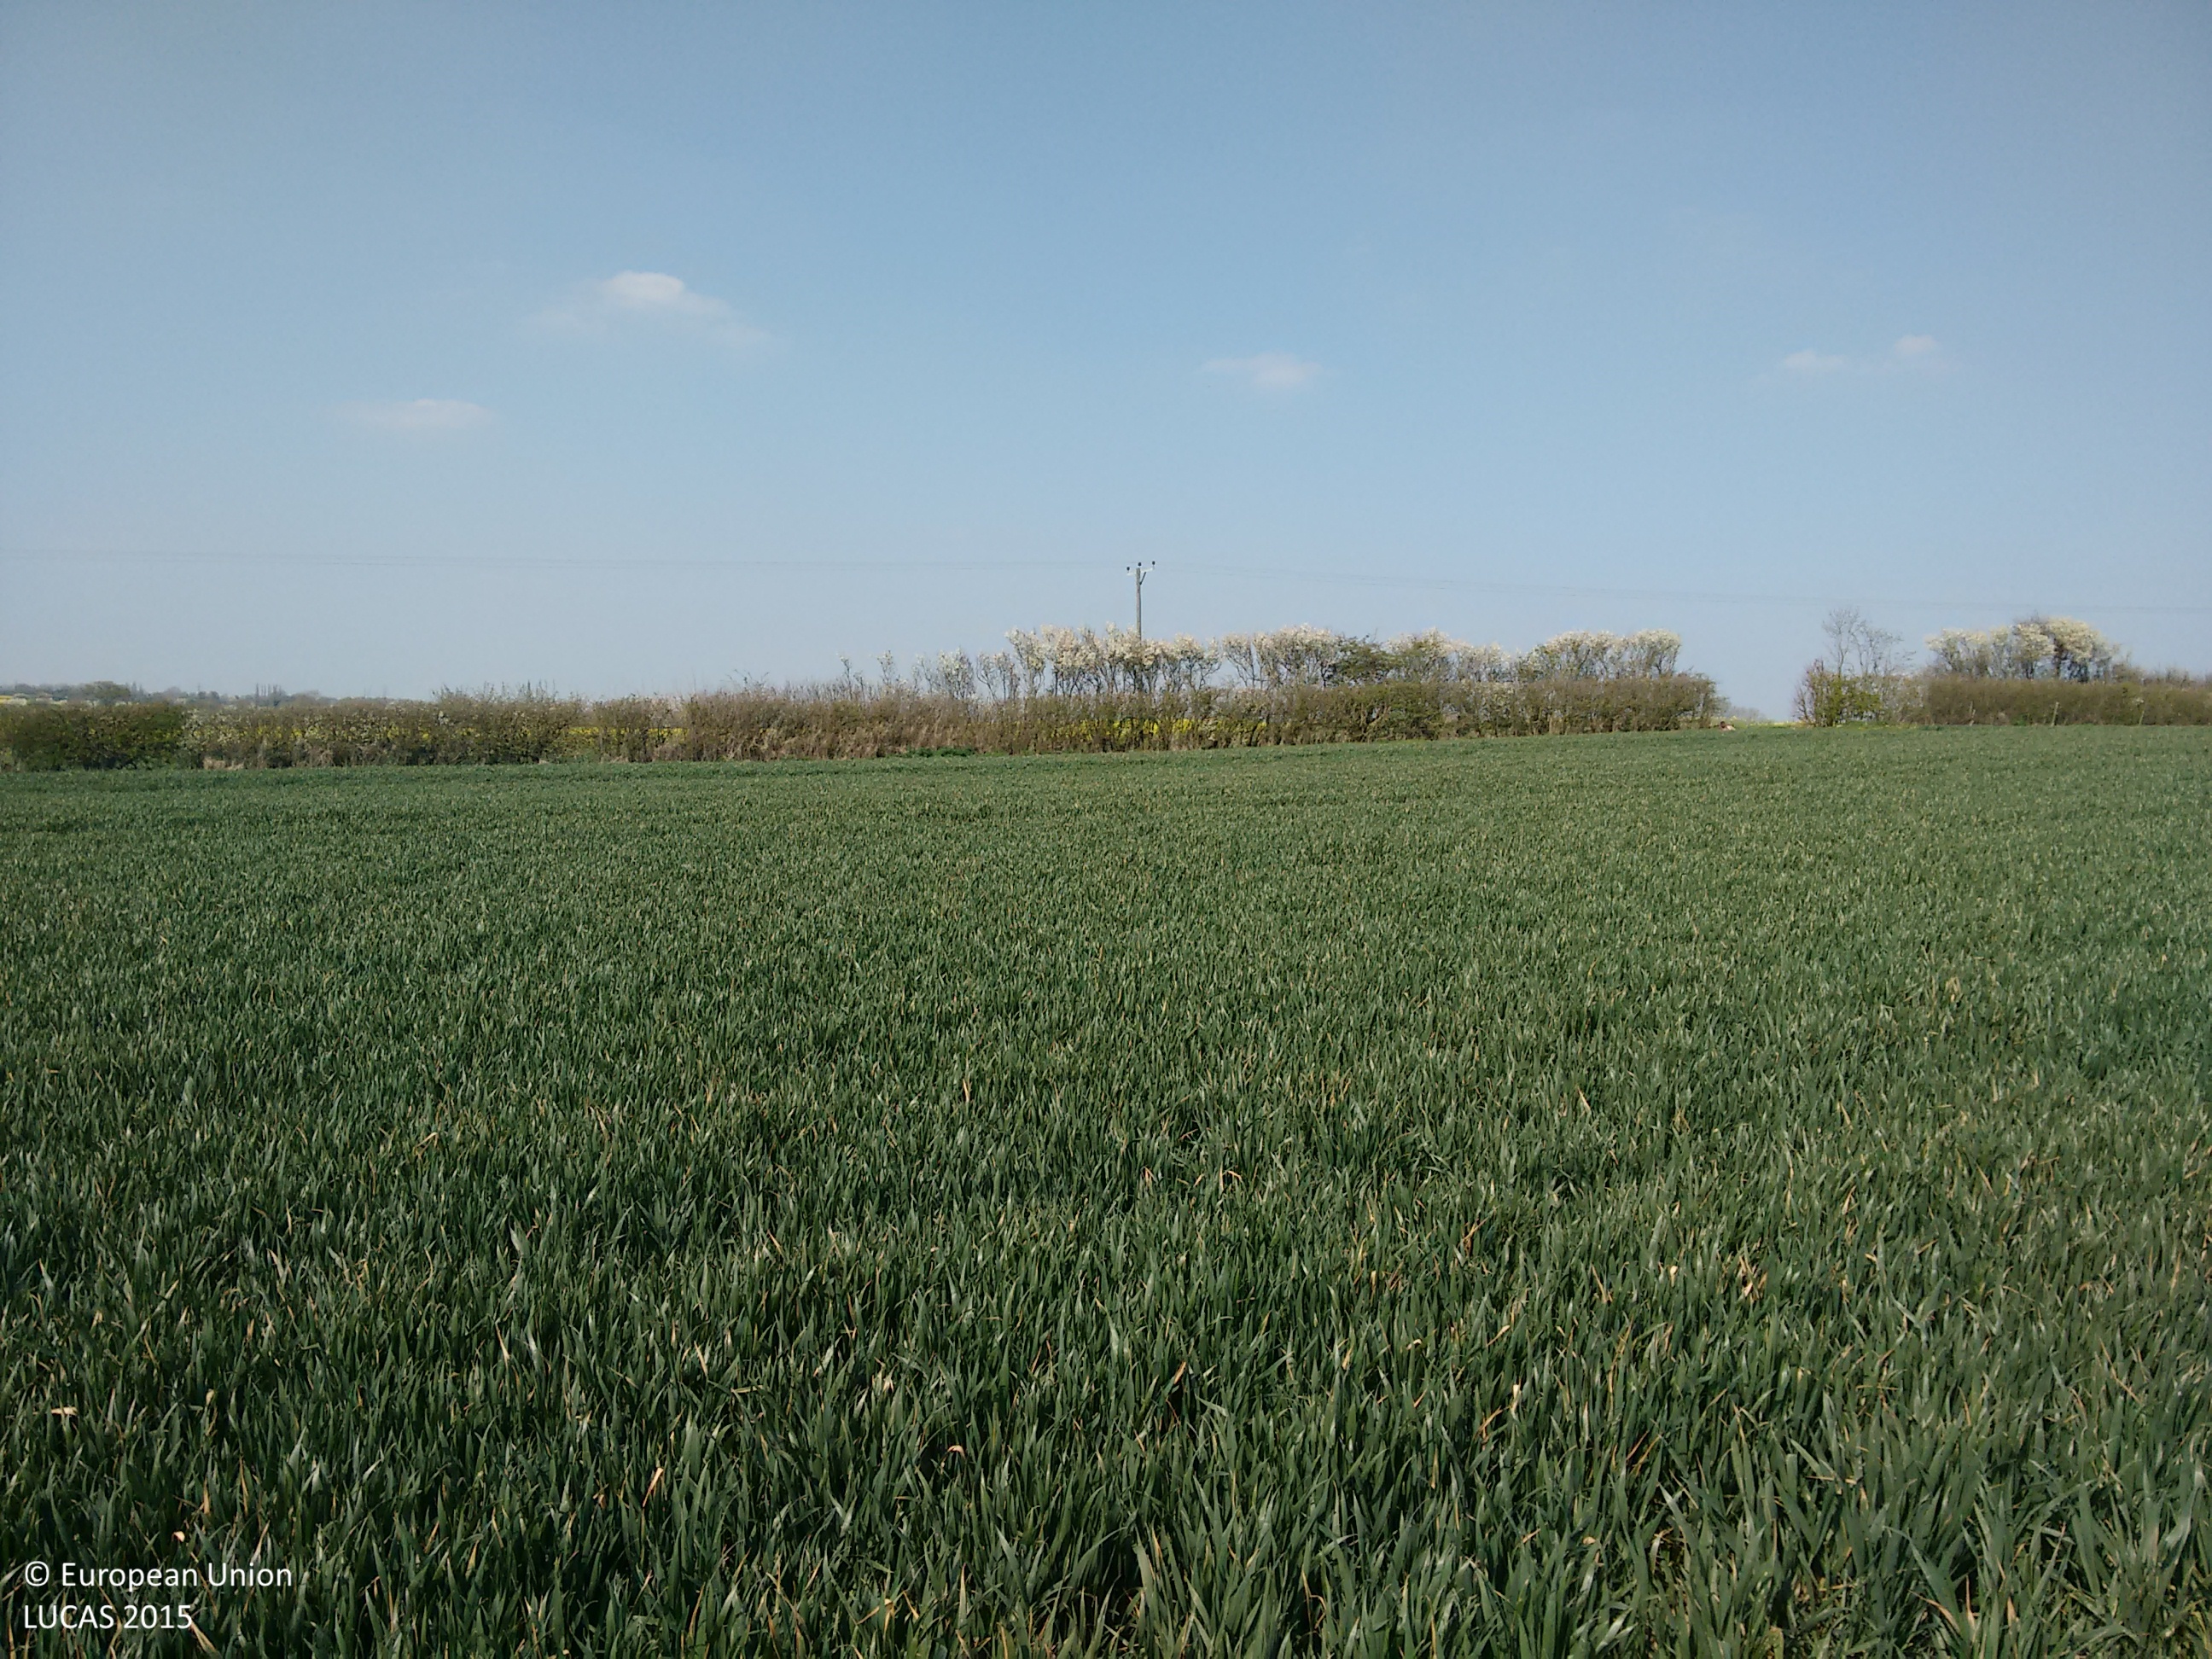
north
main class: Cropland
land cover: Common wheat
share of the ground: > 75 %
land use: Agriculture (excluding fallow land and kitchen gardens)
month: April
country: GB
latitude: 53.2914
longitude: -0.6759
